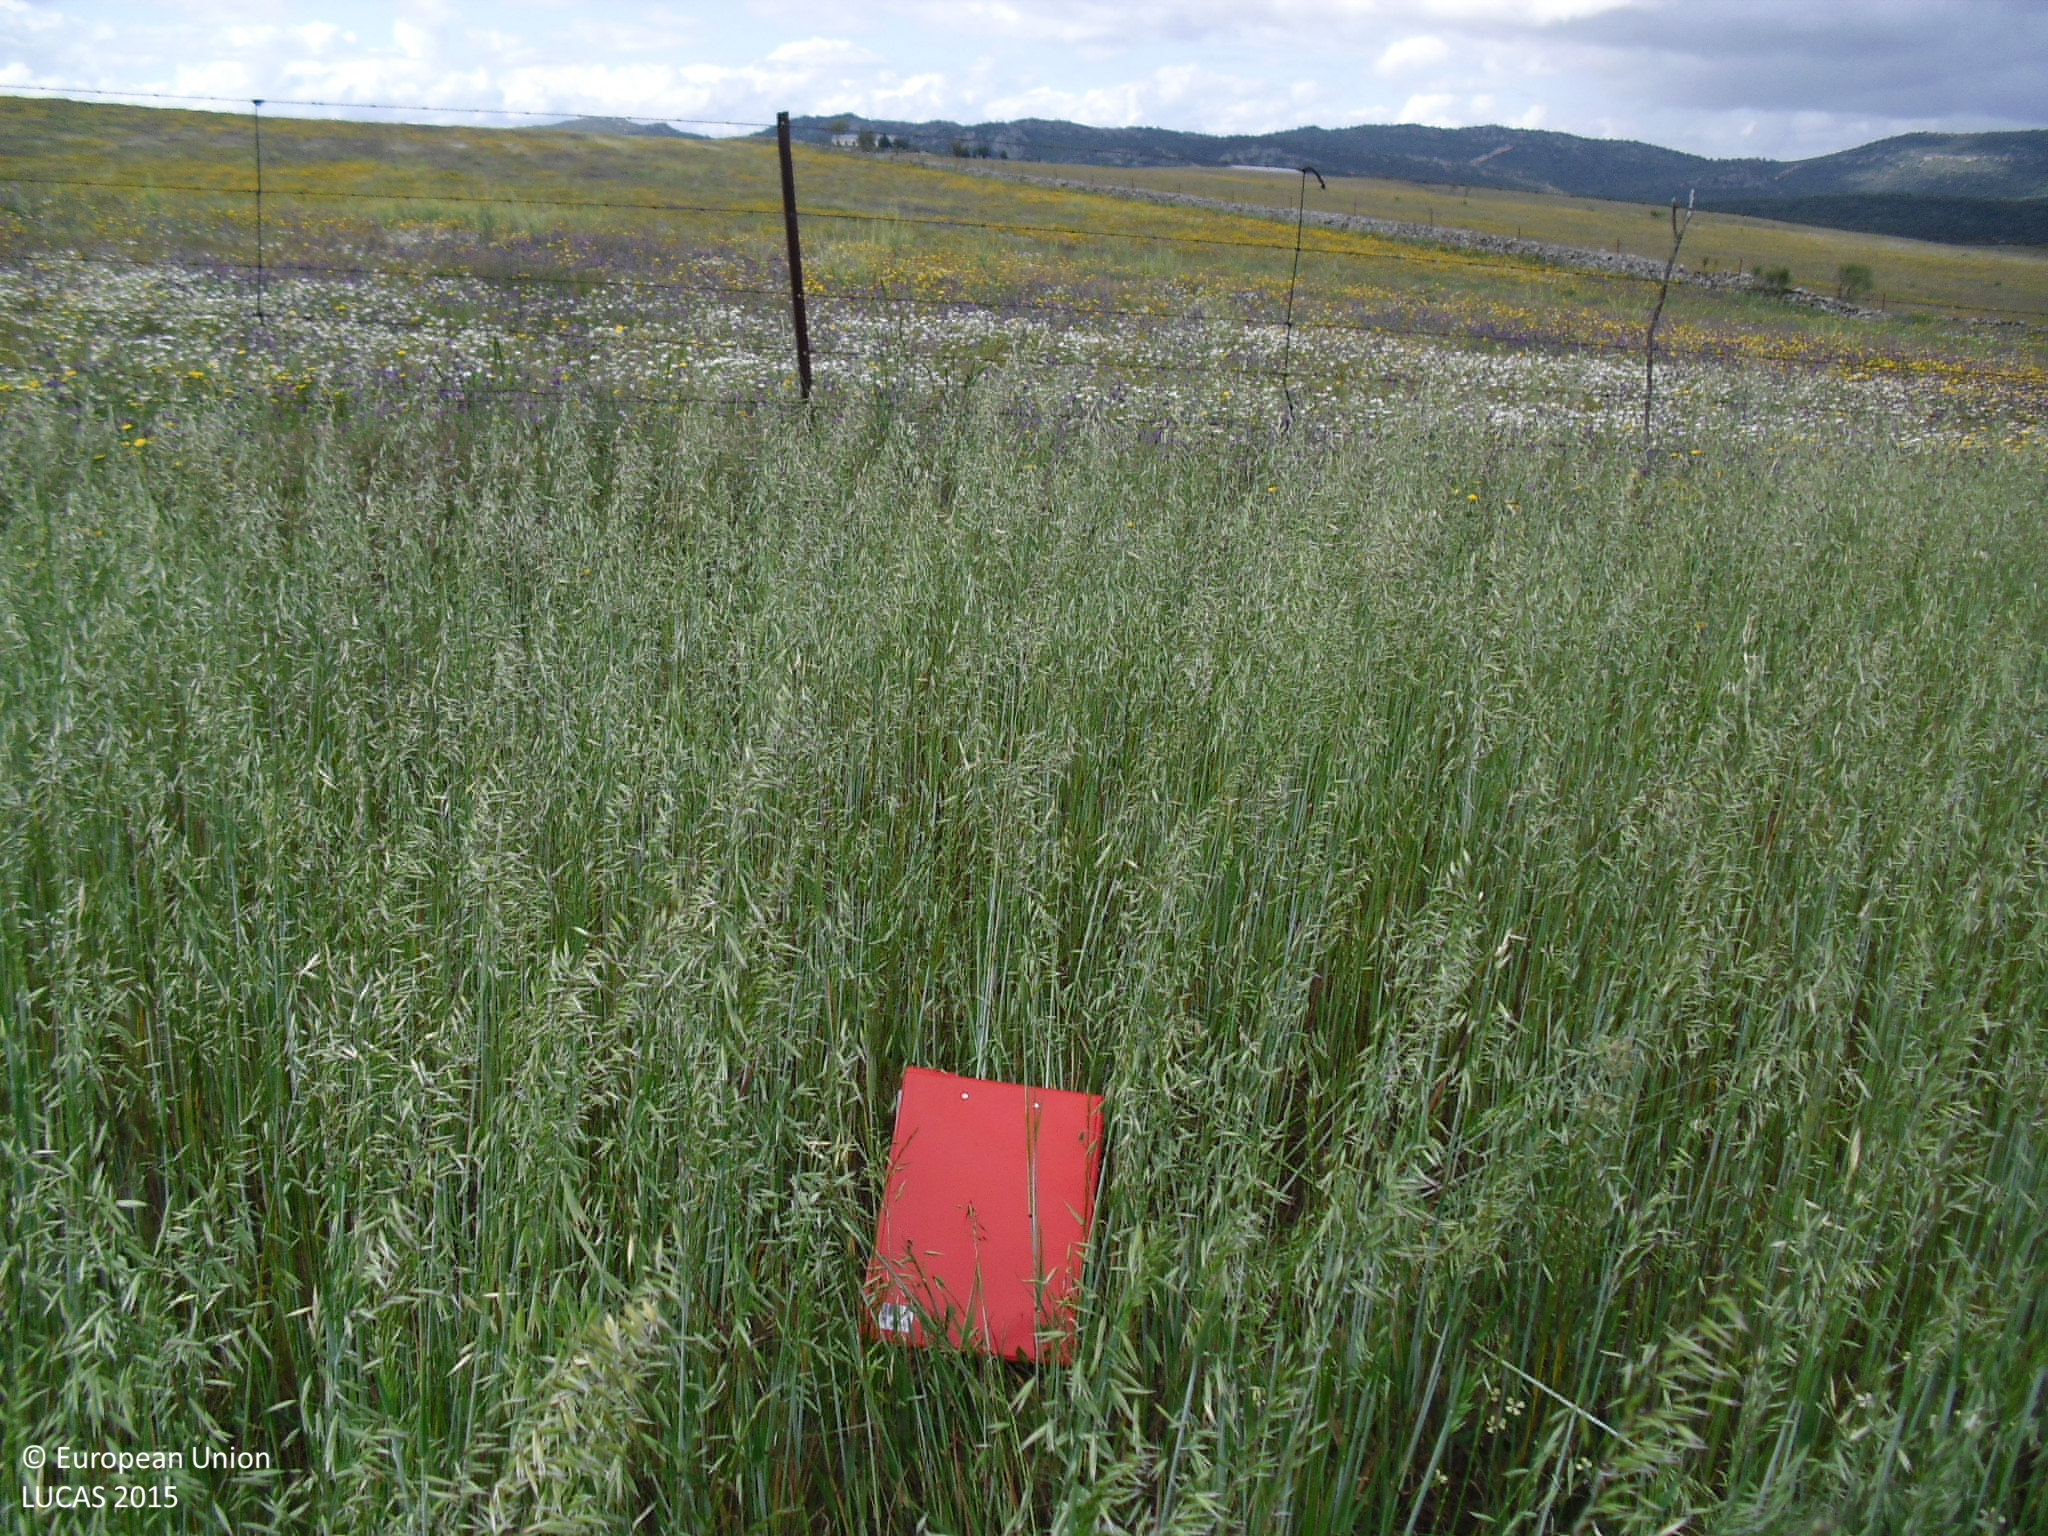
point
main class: Cropland
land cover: Oats
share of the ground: > 75 %
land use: Agriculture (excluding fallow land and kitchen gardens)
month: April
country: ES
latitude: 39.4272
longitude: -7.1489
